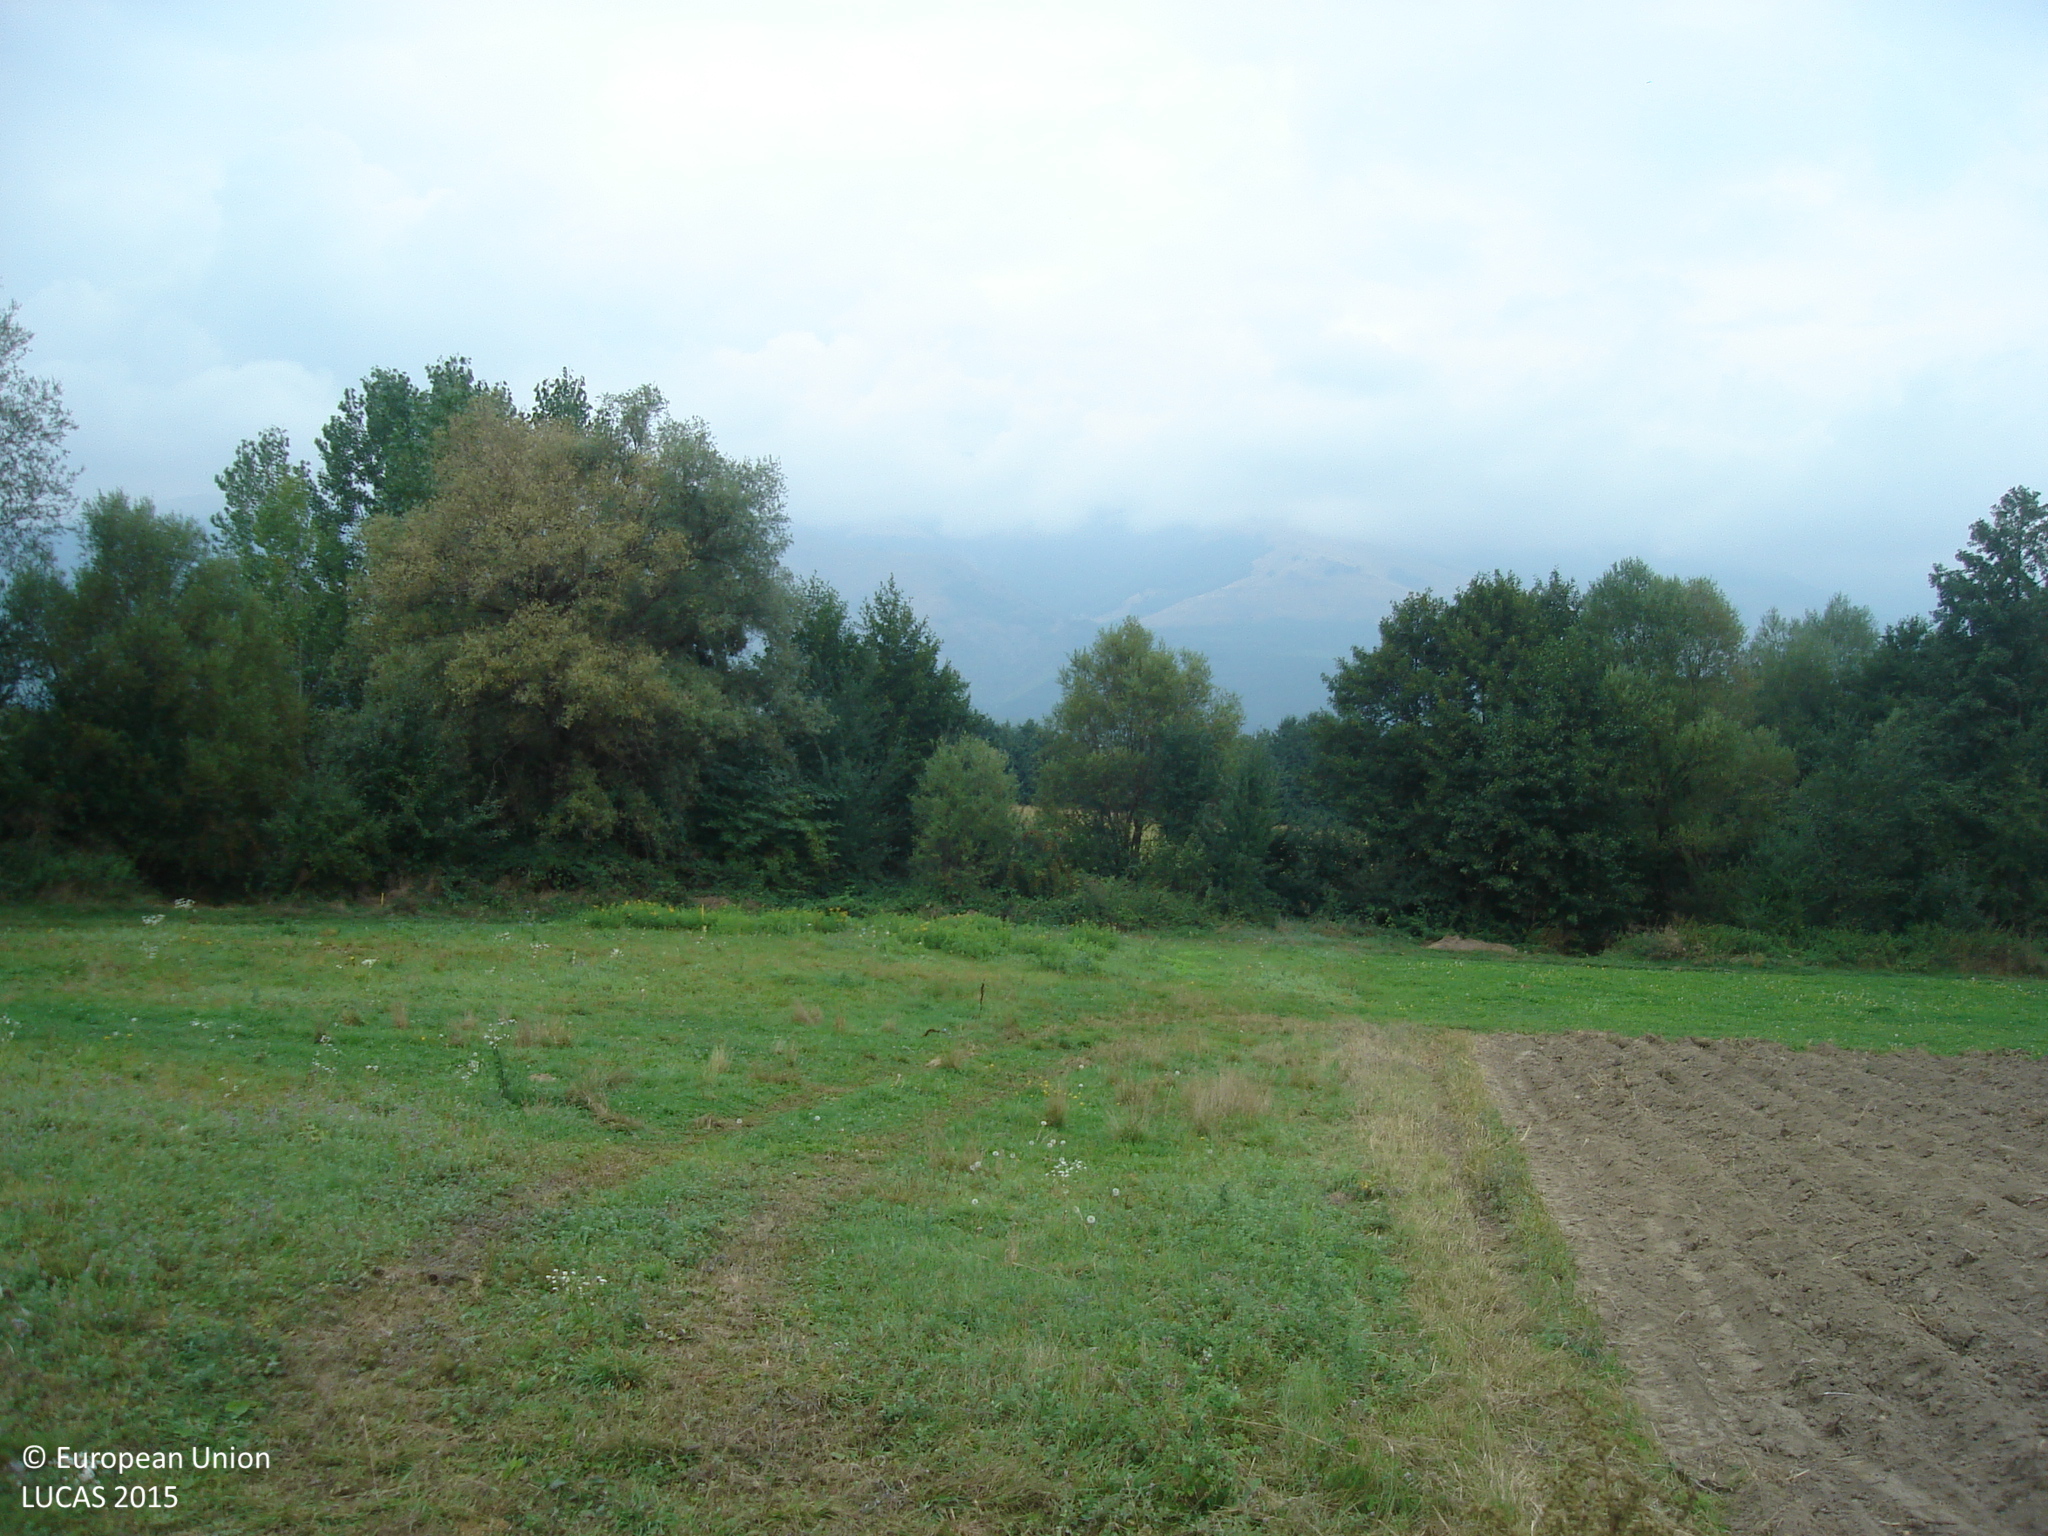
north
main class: Grassland
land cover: Grassland without tree/shrub cover
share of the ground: > 75 %
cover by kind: herbaceous plants 100 %
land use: Road transport
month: September
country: BG
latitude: 42.7063
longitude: 24.2229
